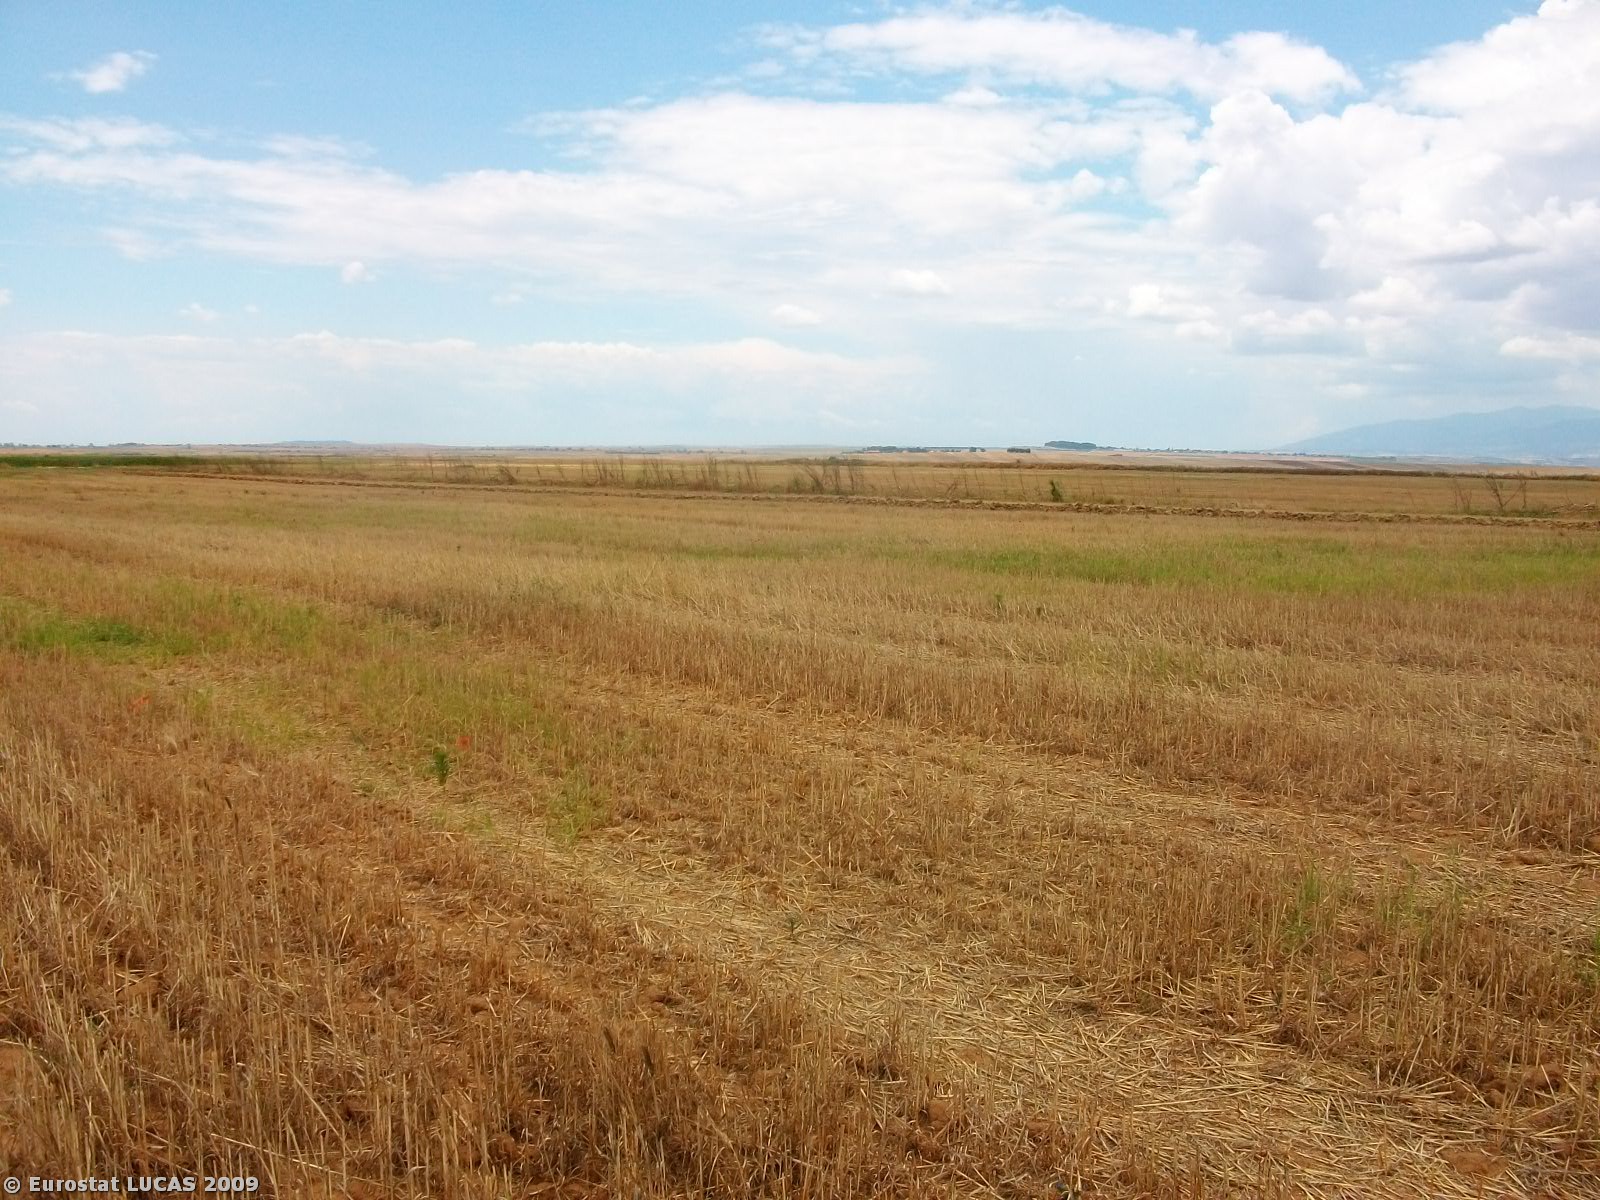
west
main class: Cropland
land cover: Barley
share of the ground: > 75 %
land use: Agriculture (excluding fallow land and kitchen gardens)
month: June
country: GR
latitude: 40.8807
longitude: 22.7170
